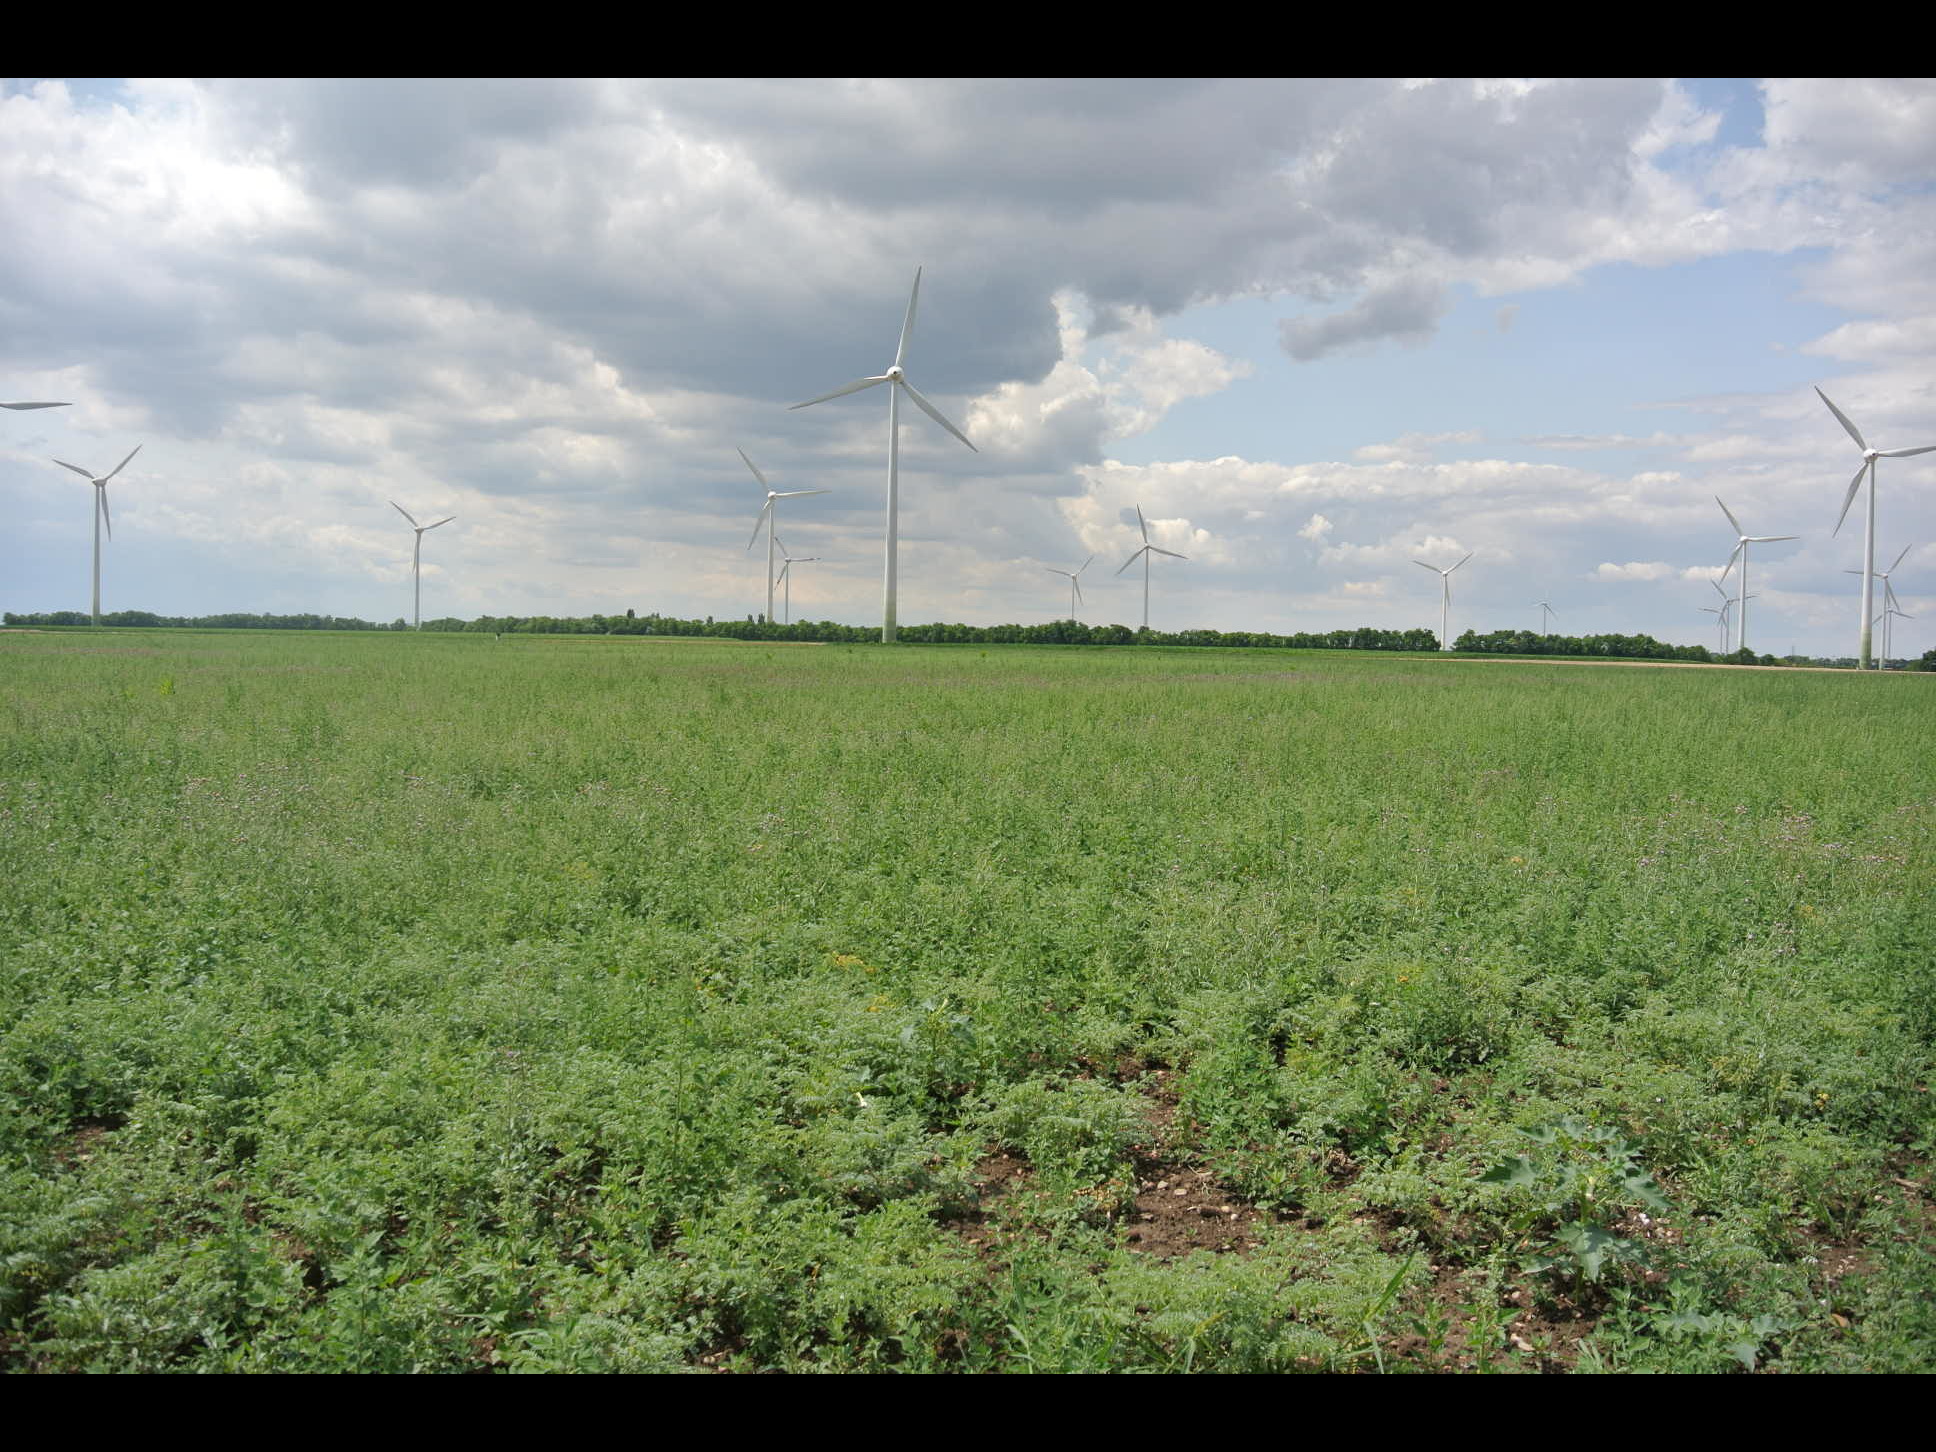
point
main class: Cropland
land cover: Dry pulses
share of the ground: > 75 %
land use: Agriculture (excluding fallow land and kitchen gardens)
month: July
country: AT
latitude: 47.9529
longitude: 16.9026
